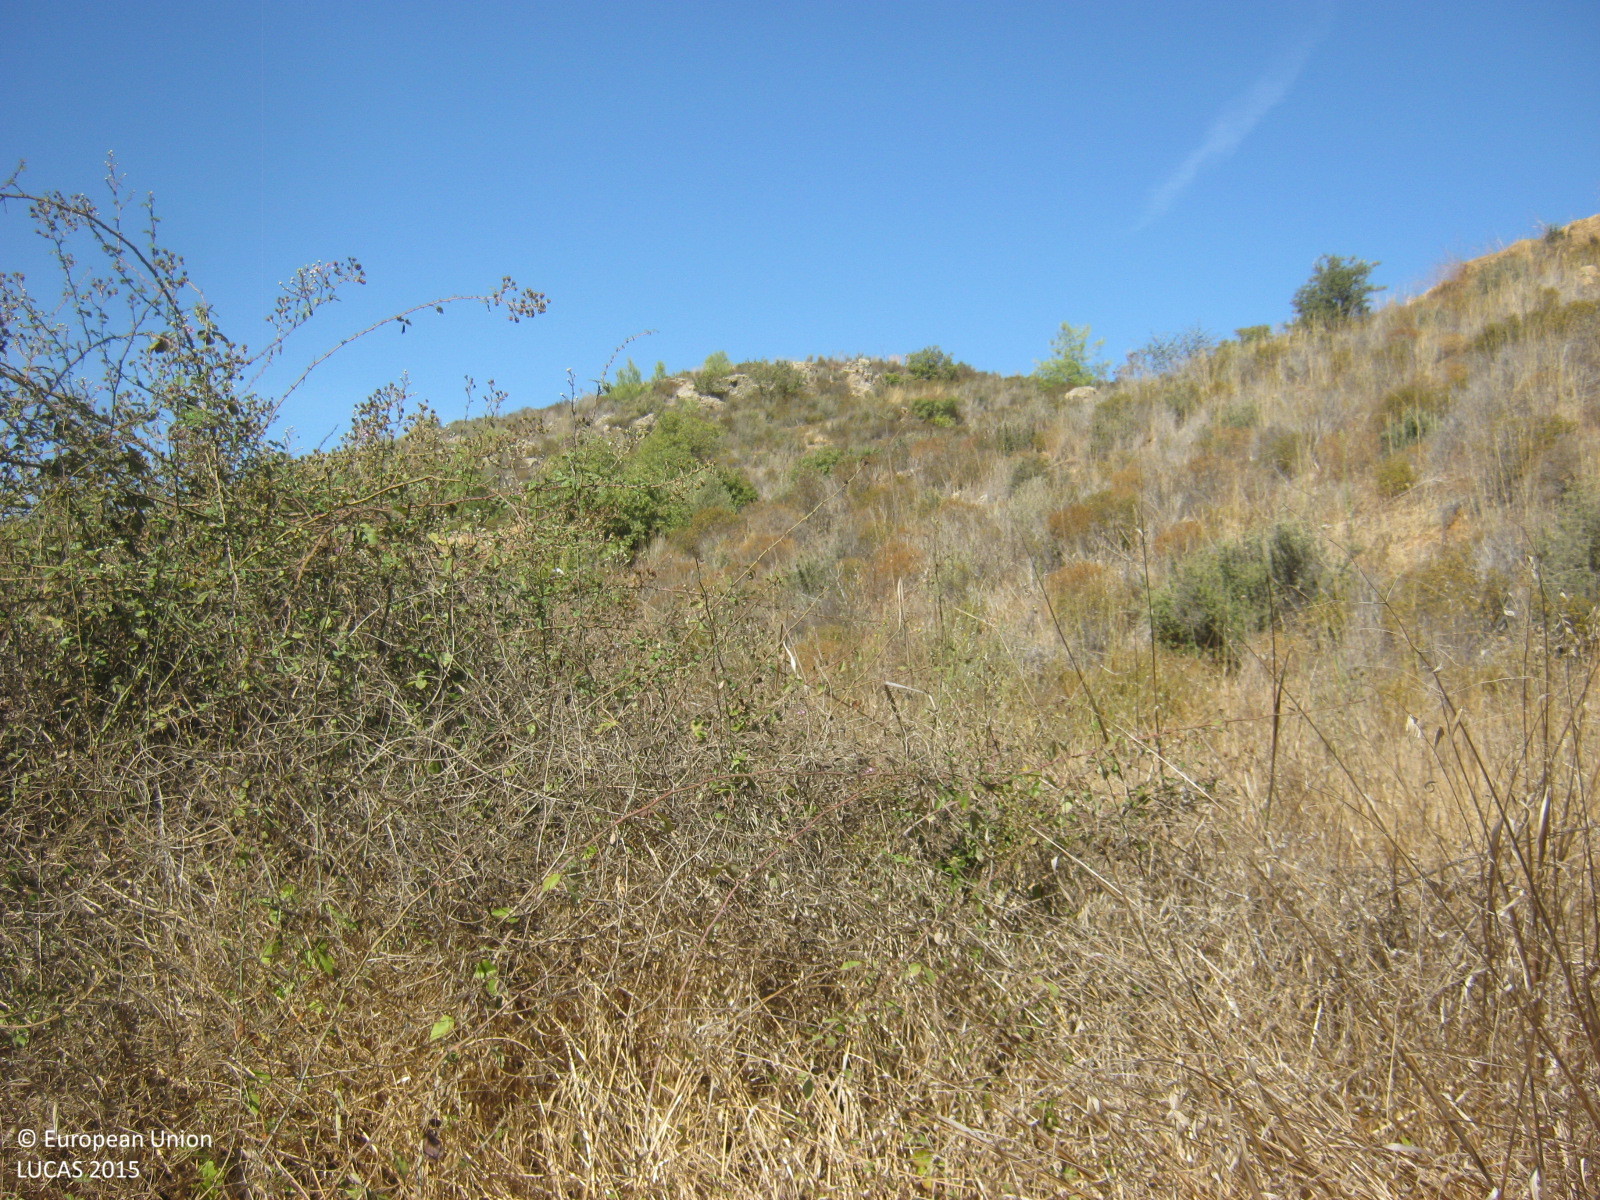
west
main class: Shrubland
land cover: Shrubland without tree cover
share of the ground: 50 - 75 %
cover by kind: shrubs 50 %, unconsolidated bare surface 30 %, herbaceous plants 20 %
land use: Semi-natural and natural areas not in use
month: April
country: CY
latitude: 34.9435
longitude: 33.3661
